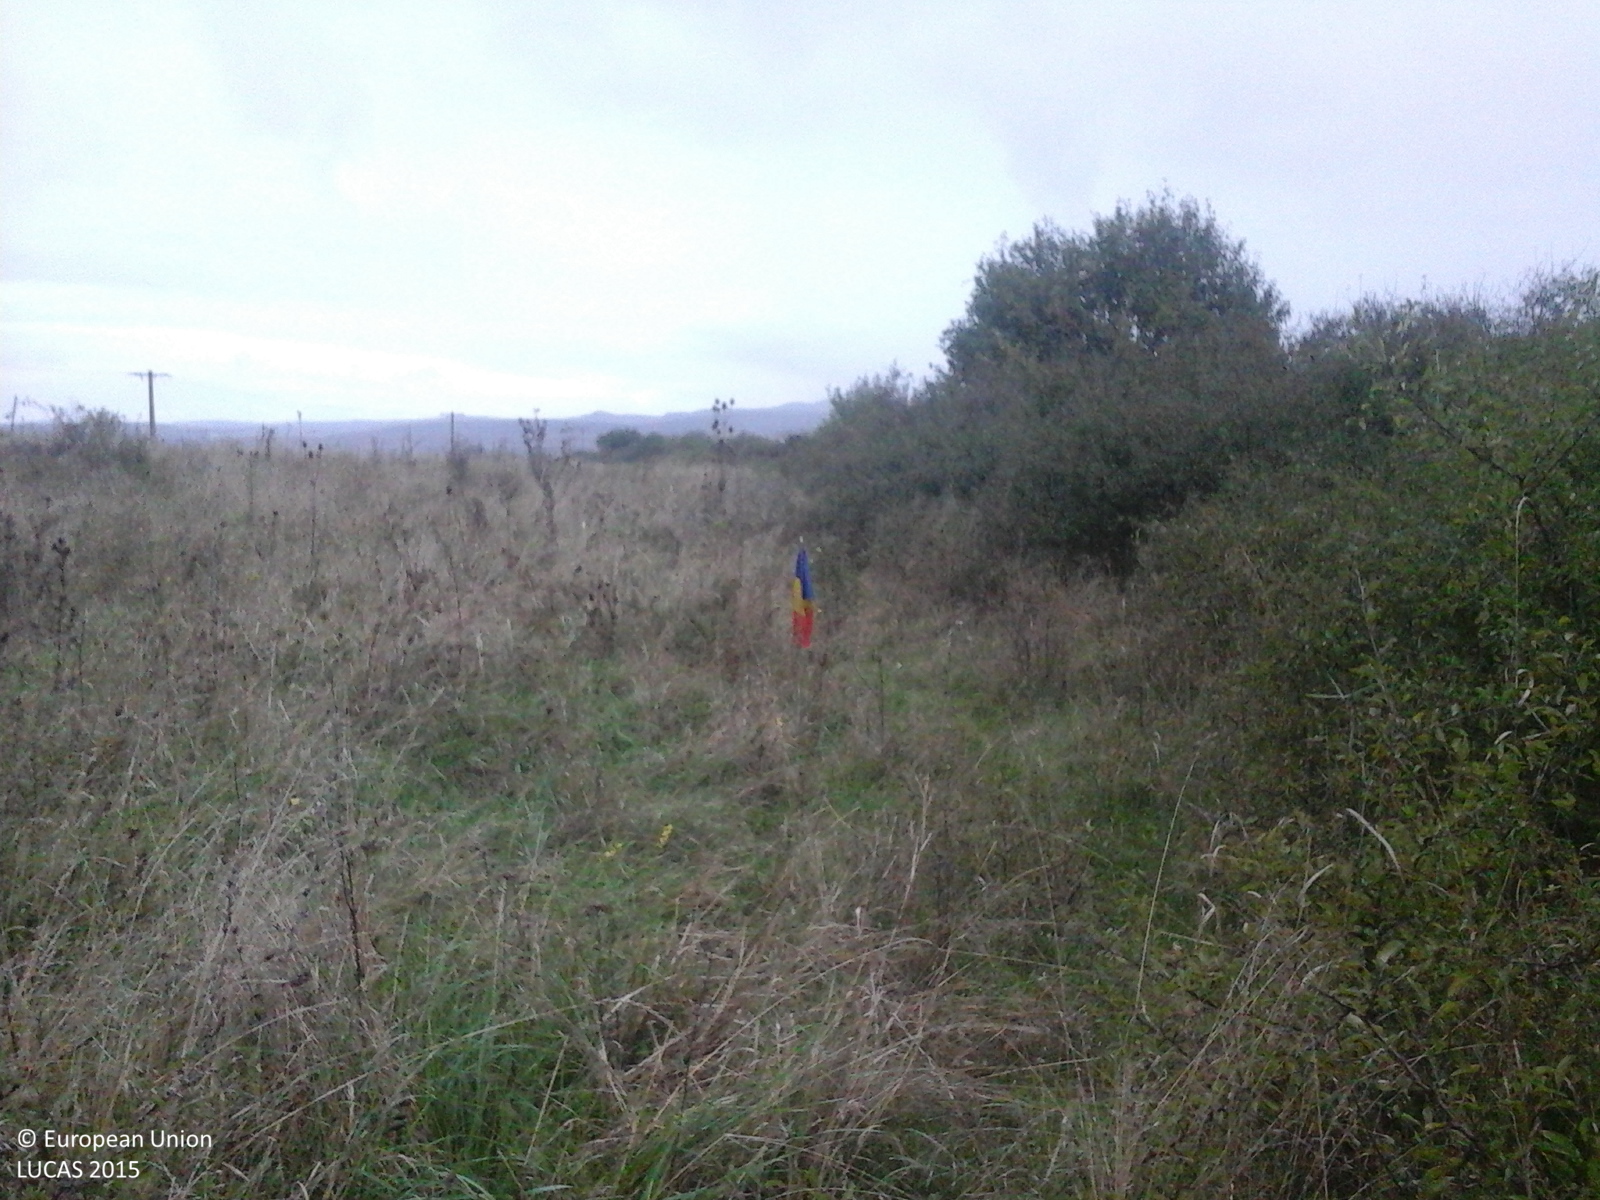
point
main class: Grassland
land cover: Grassland with sparse tree/shrub cover
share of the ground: > 75 %
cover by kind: herbaceous plants 85 %, shrubs 10 %, broadleaved forest trees 5 %
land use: Fallow land
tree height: < 5 m
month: September
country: RO
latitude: 45.8520
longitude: 23.8099
